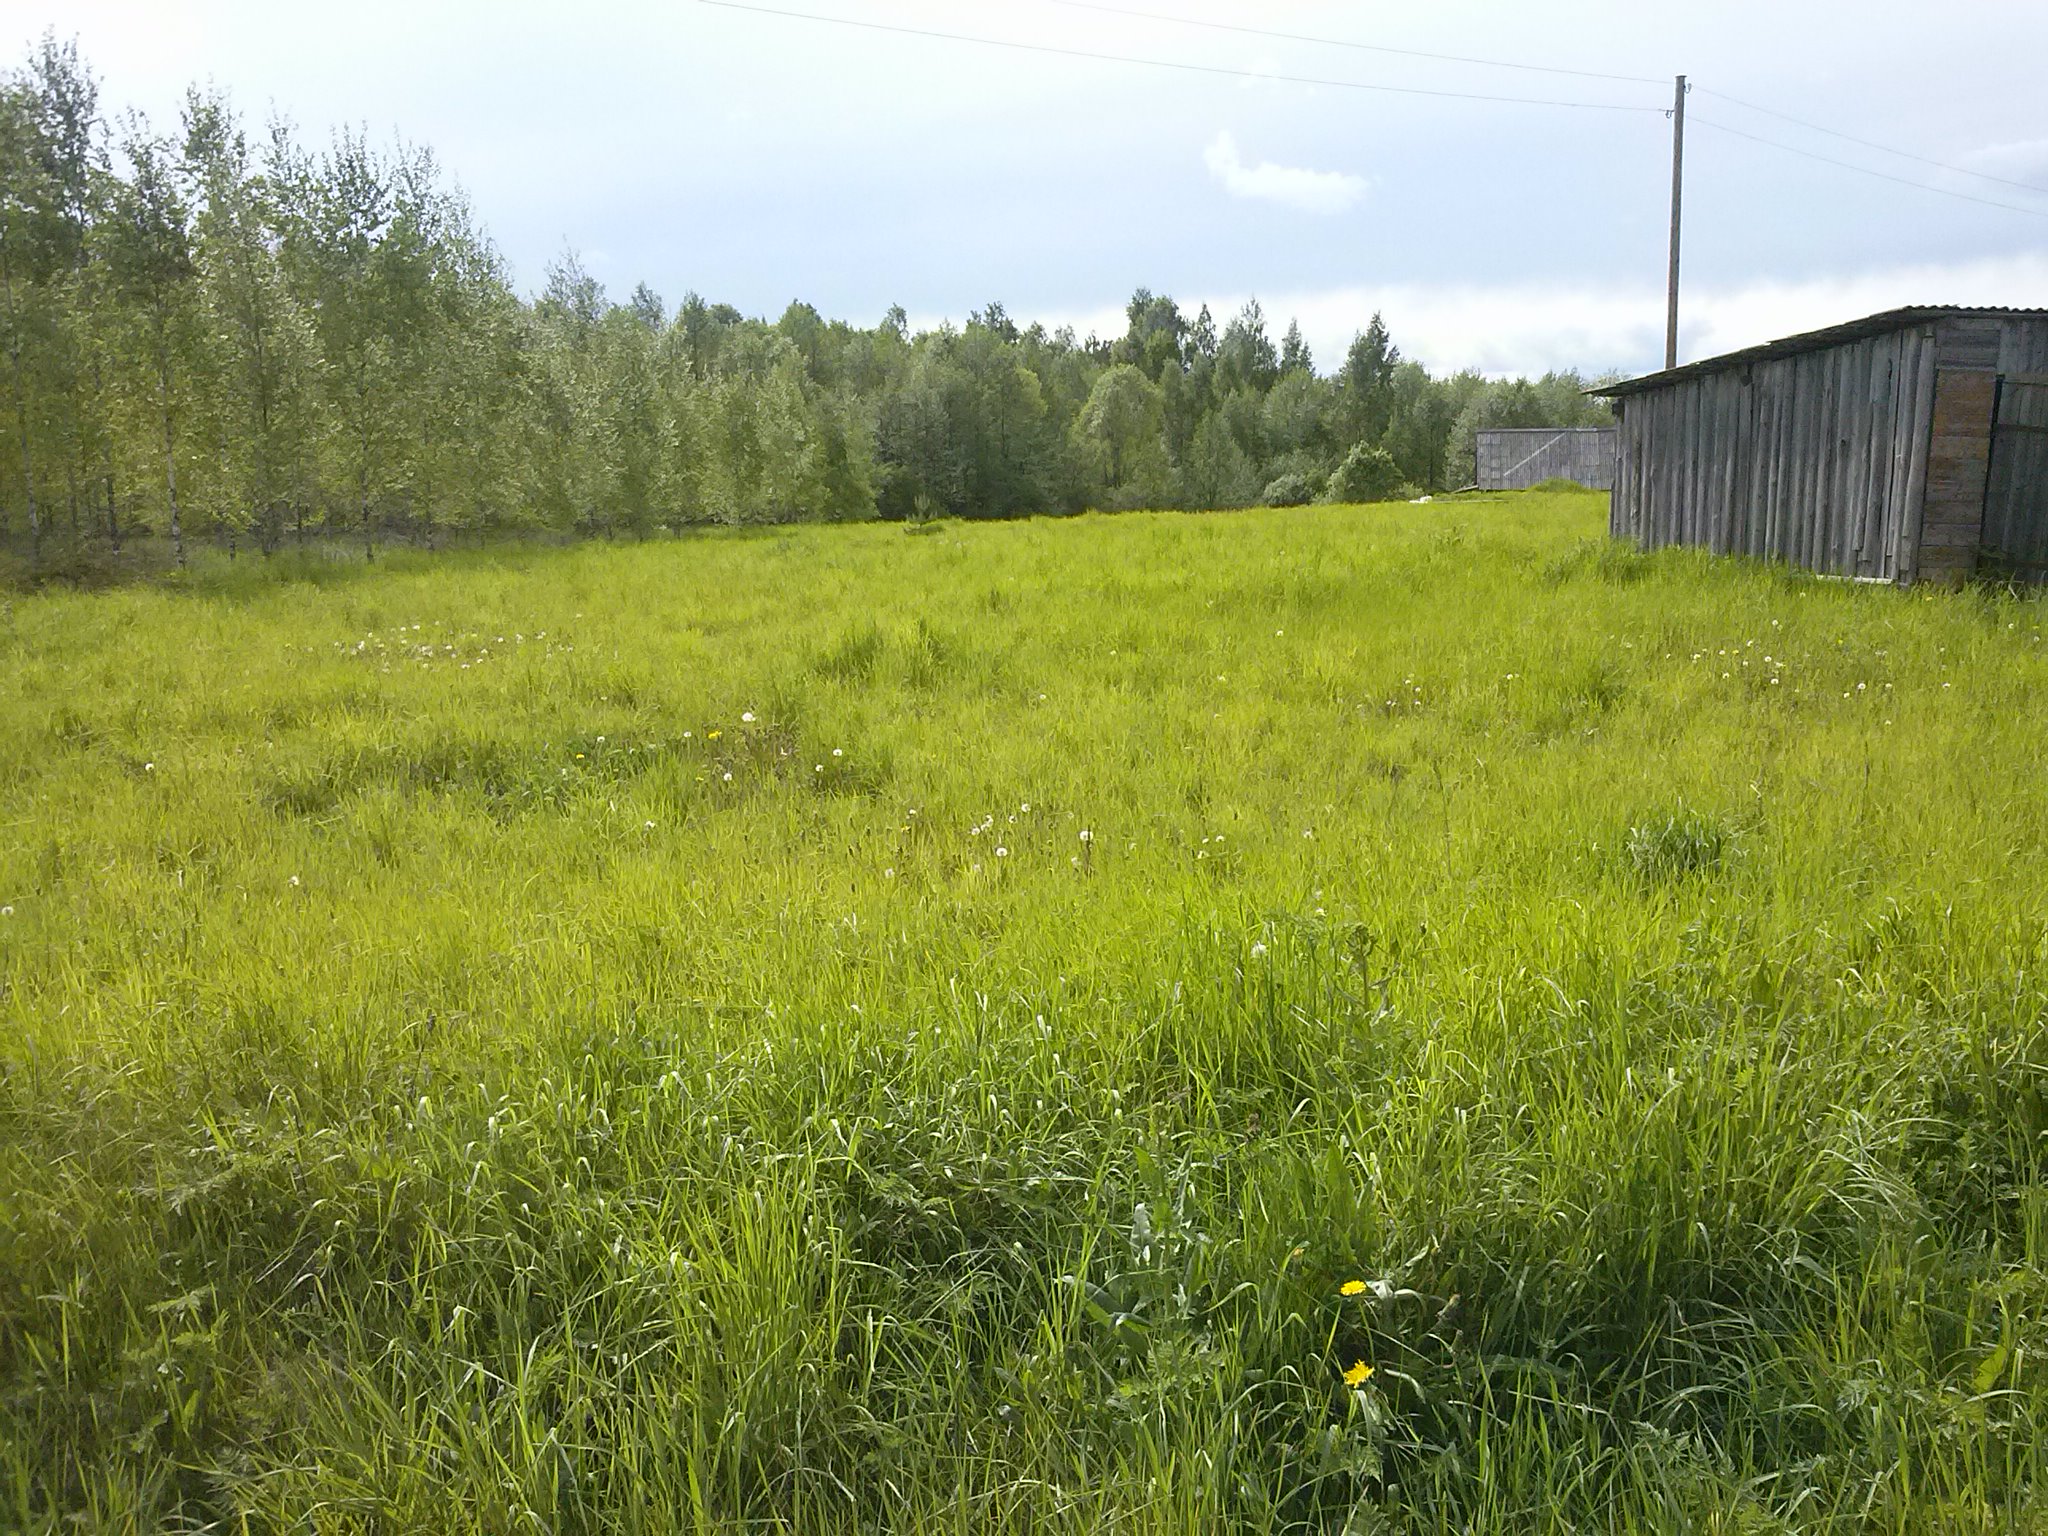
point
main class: Grassland
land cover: Grassland without tree/shrub cover
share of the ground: > 75 %
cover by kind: herbaceous plants 100 %
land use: Agriculture (excluding fallow land and kitchen gardens)
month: May
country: LV
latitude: 56.2399
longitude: 27.7937
